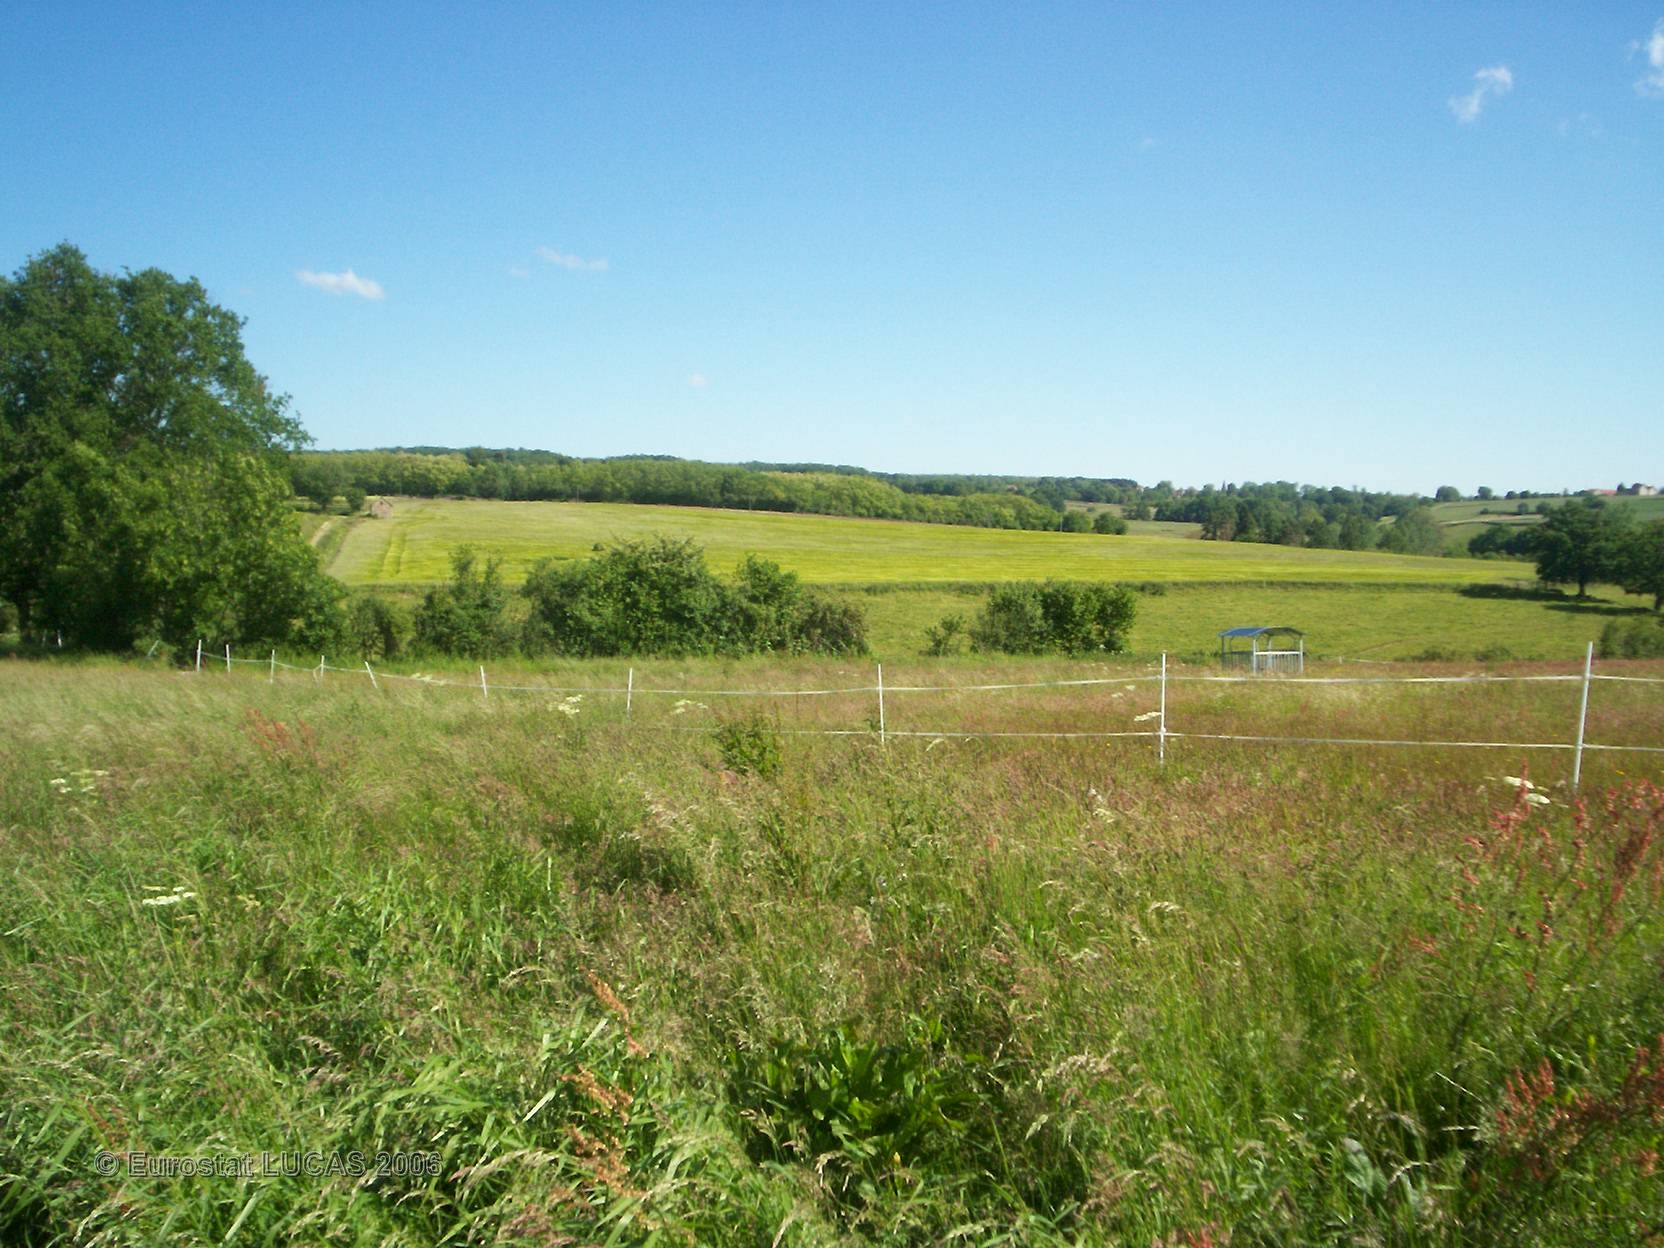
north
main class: Grassland
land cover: Grassland without tree/shrub cover
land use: Agriculture (excluding fallow land and kitchen gardens)
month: June
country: FR
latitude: 46.1395
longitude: 2.9950
